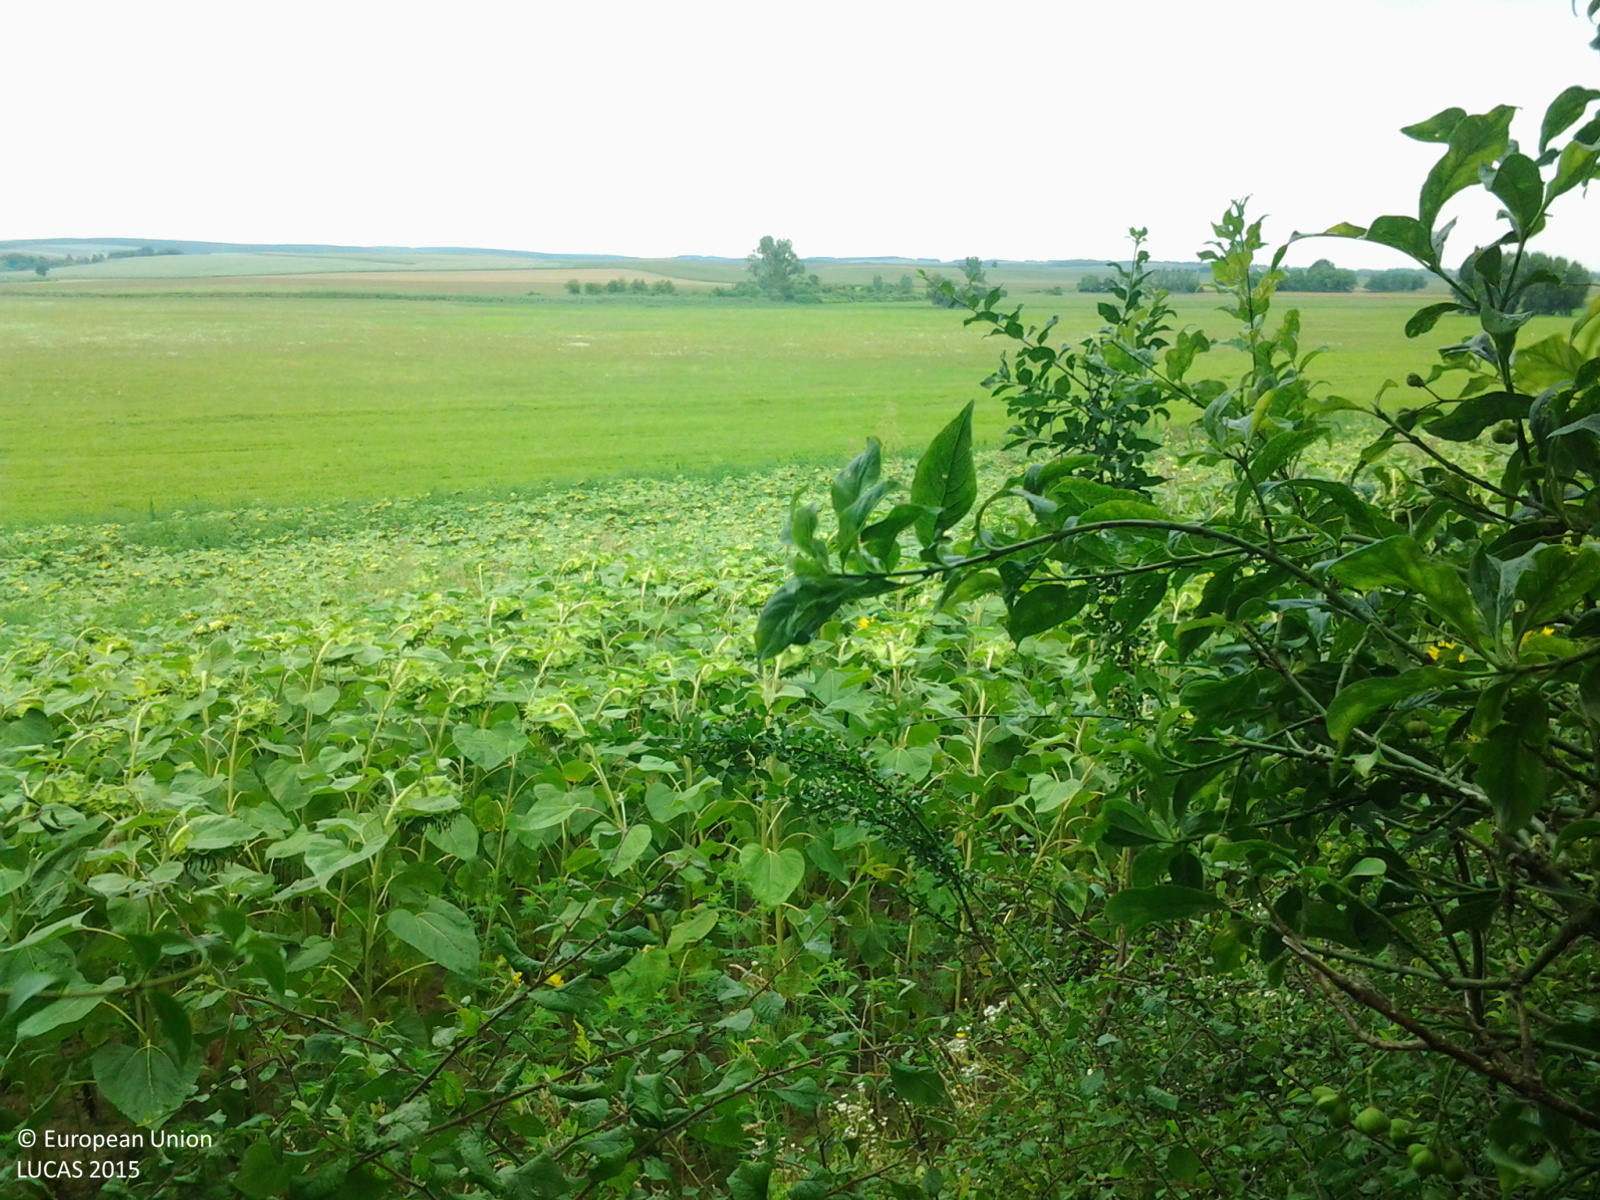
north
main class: Woodland
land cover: Broadleaved woodland
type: mesophytic deciduous forest
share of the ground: > 75 %
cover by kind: broadleaved forest trees 80 %, shrubs 20 %
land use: Forestry
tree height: > 5 m
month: July
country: HU
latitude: 46.5299
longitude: 18.3666
